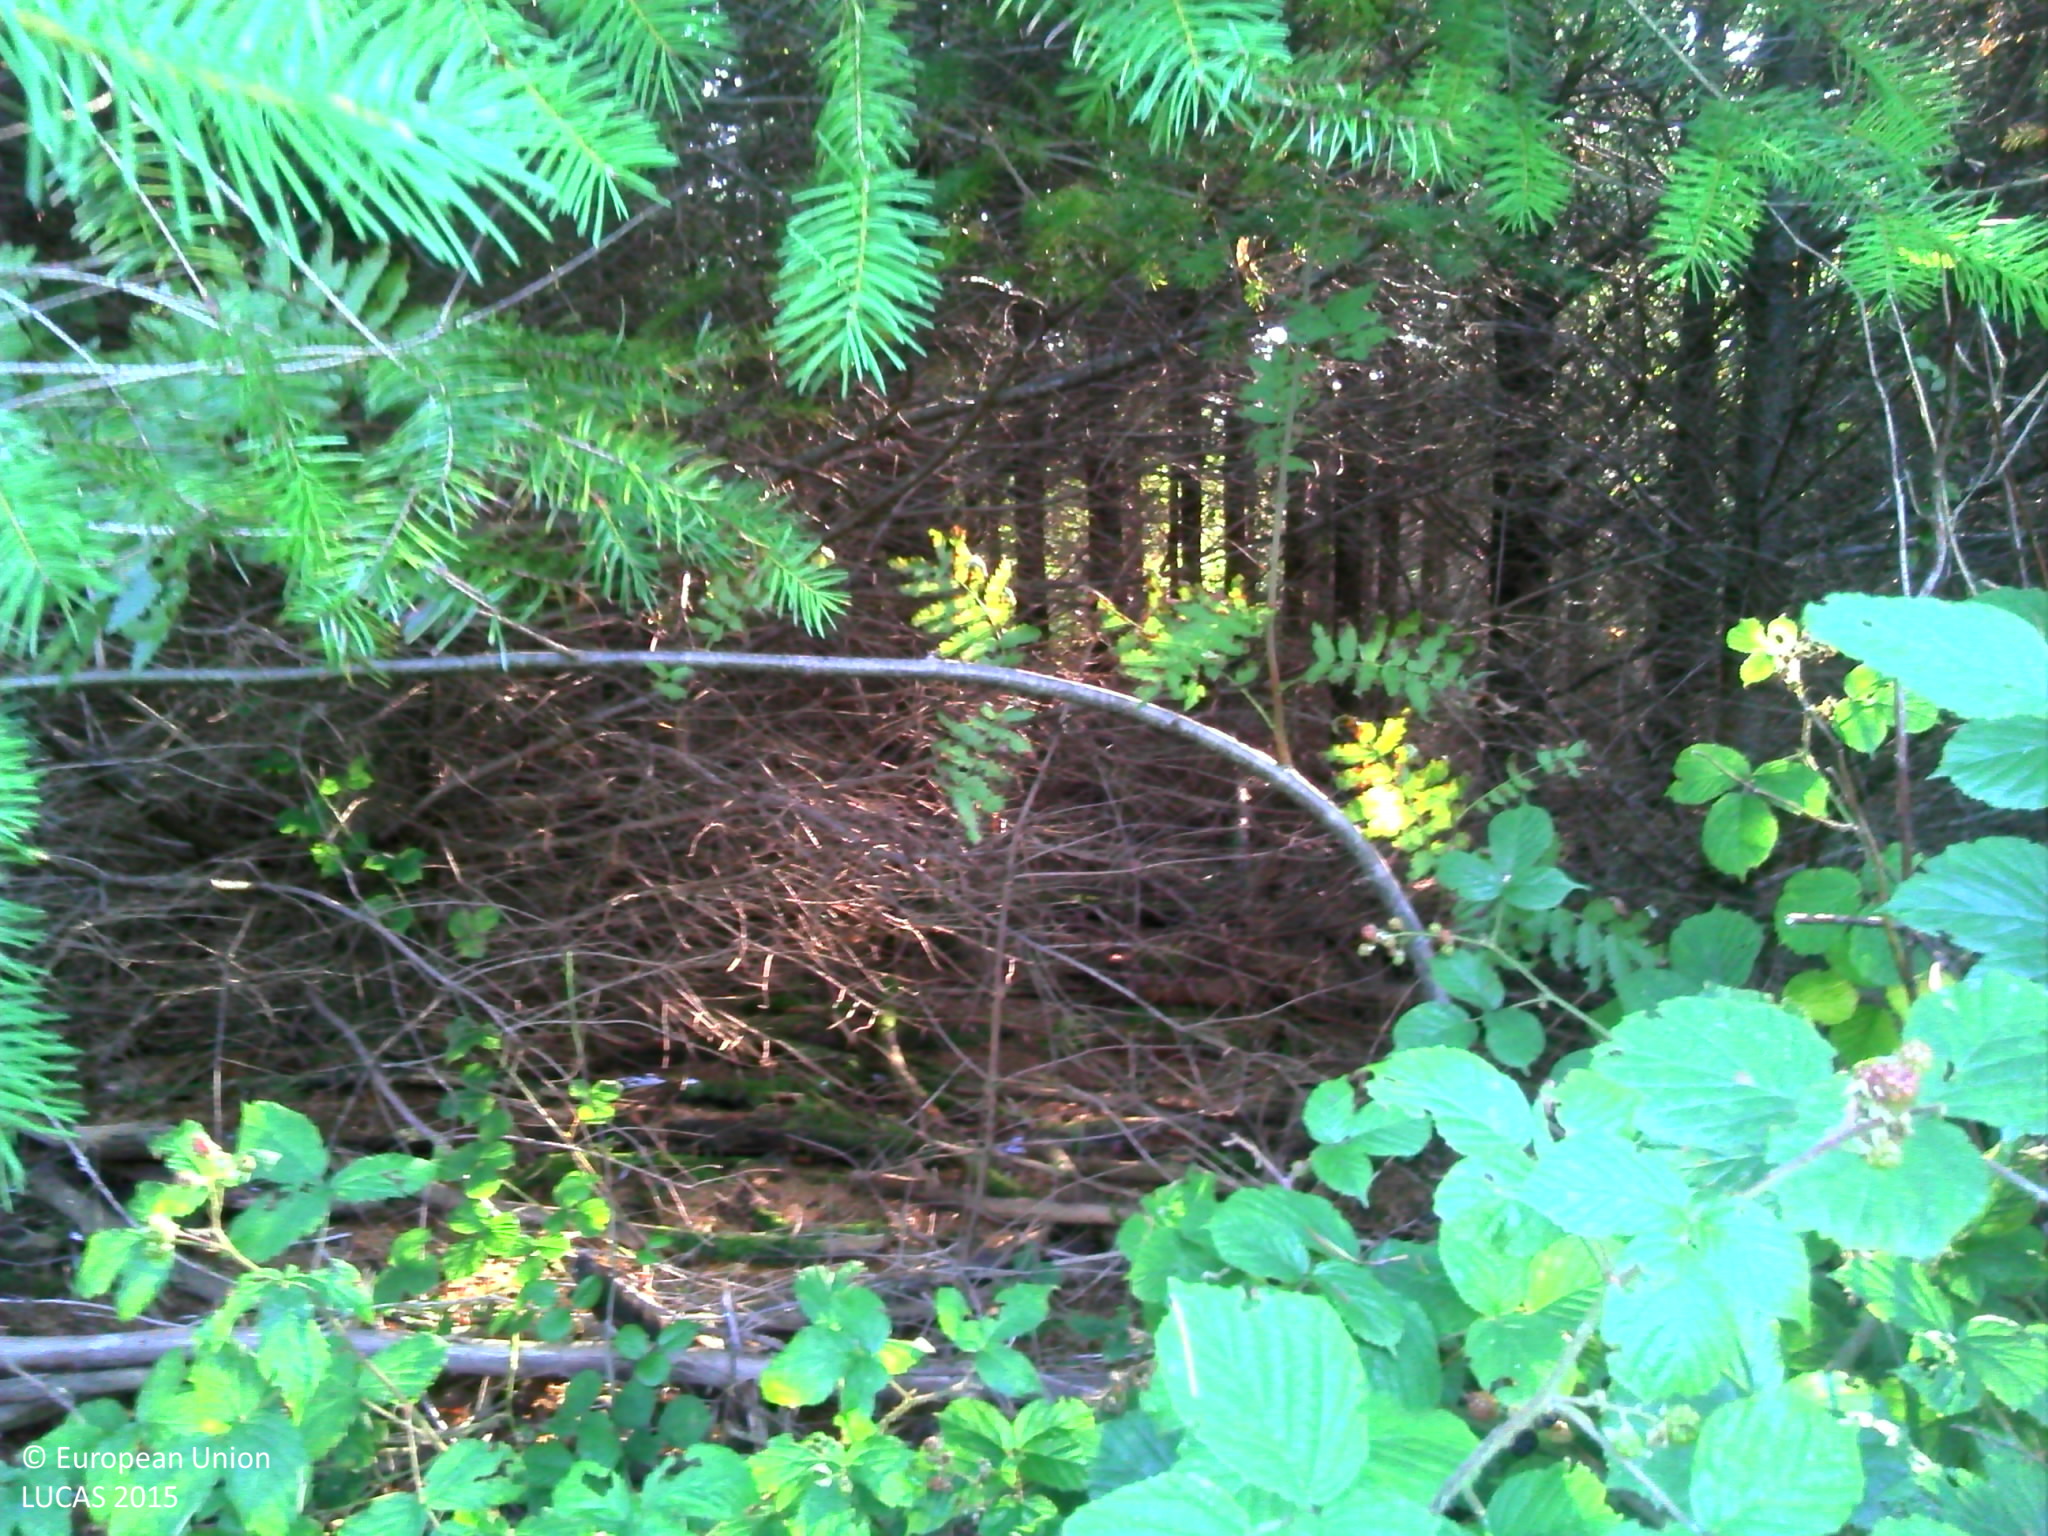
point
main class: Woodland
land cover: Spruce dominated coniferous woodland
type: exotic forest
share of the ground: > 75 %
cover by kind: coniferous forest trees 90 %, herbaceous plants 10 %
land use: Forestry
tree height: > 5 m
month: August
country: FR
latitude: 46.1954
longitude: 4.5727
